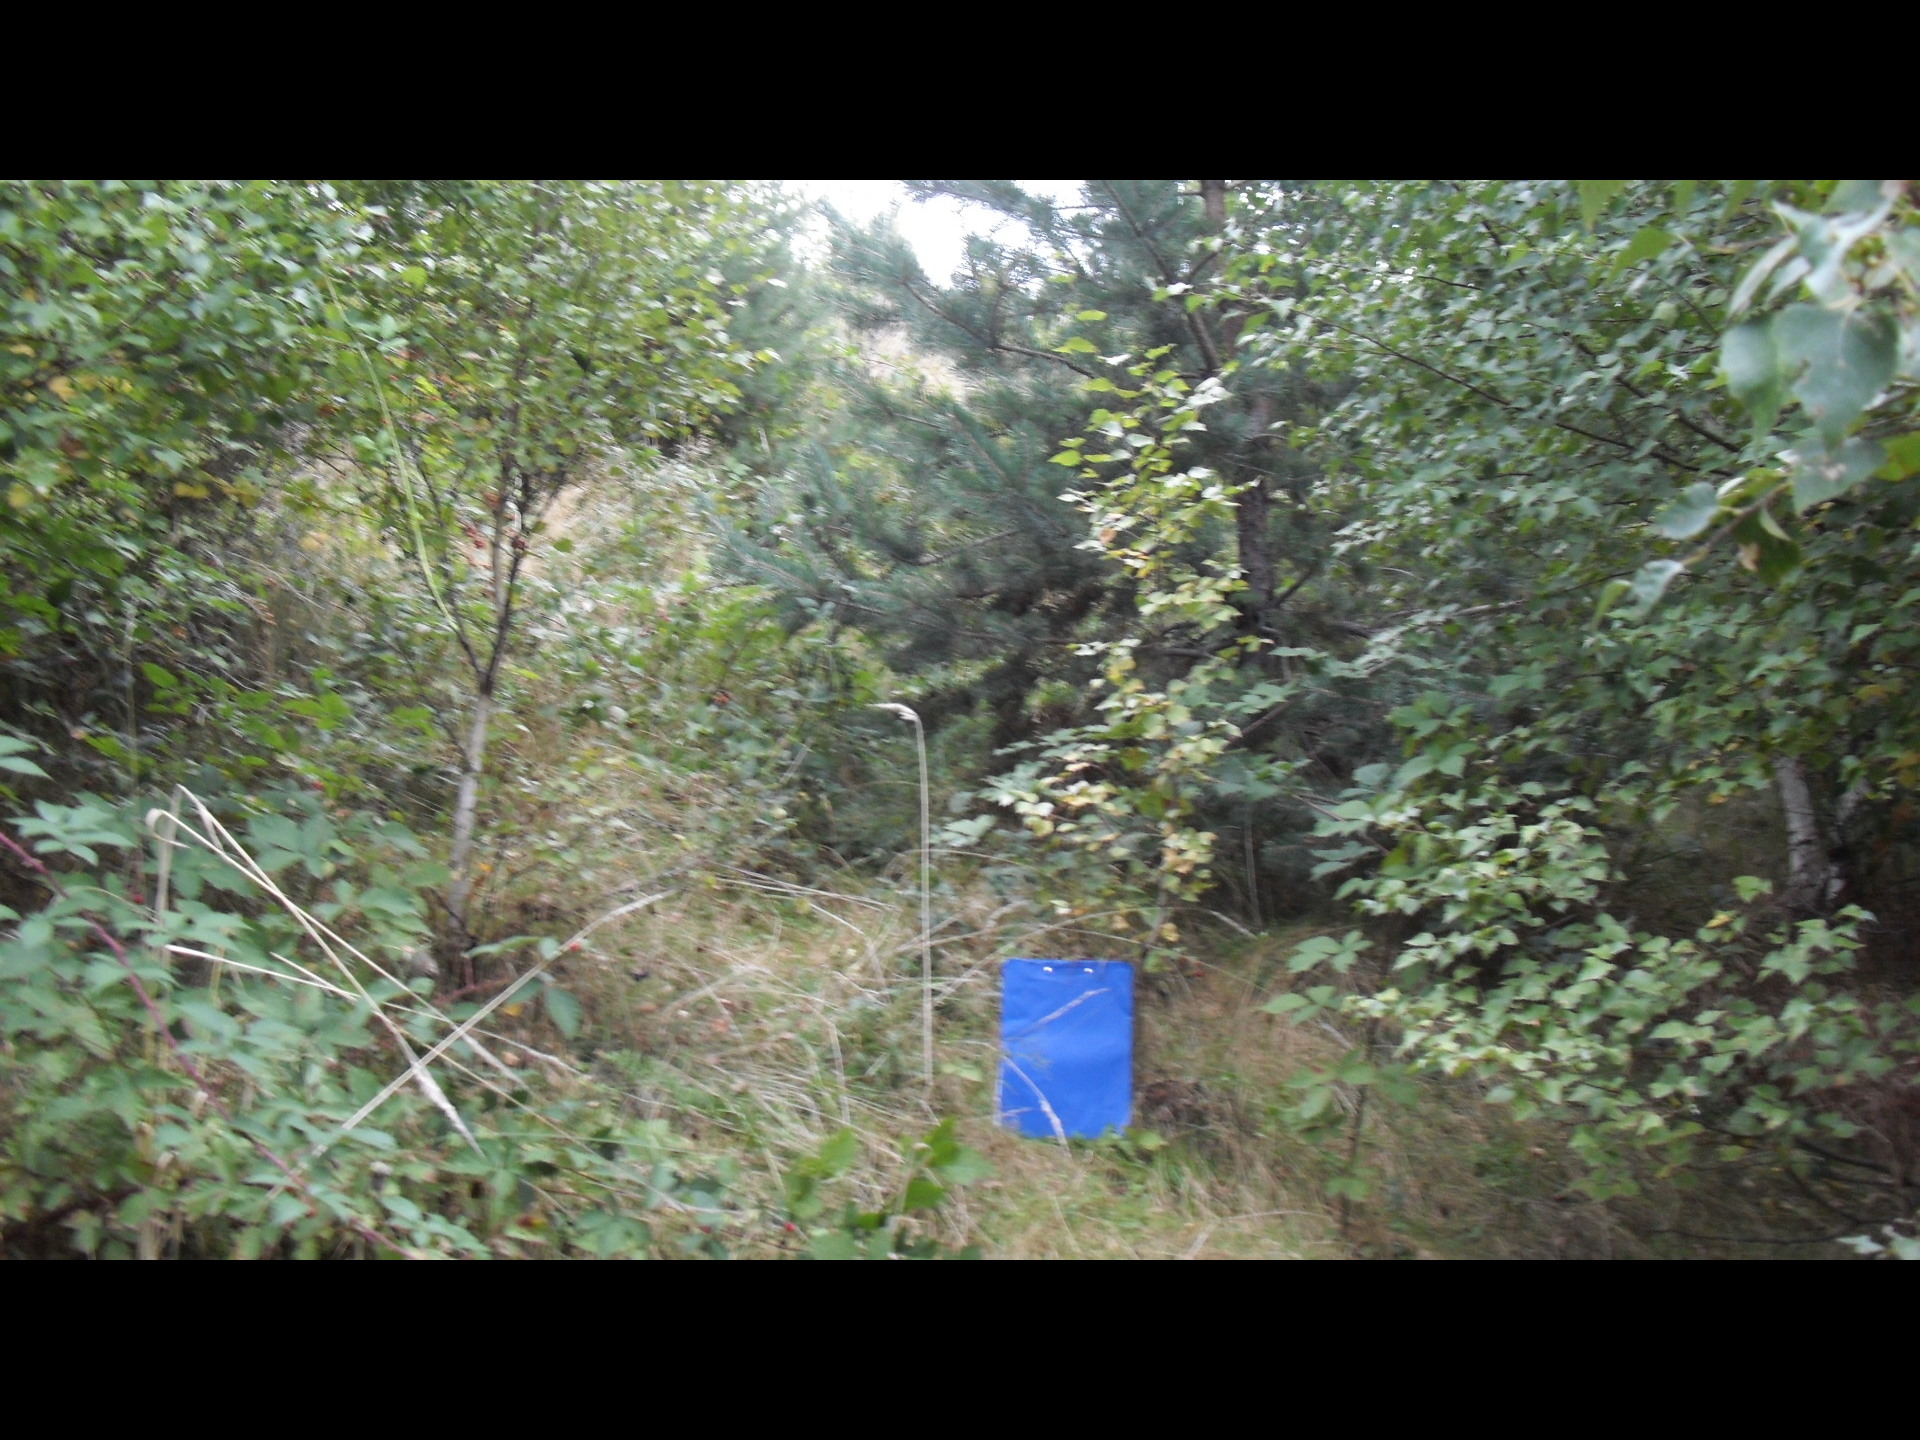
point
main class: Woodland
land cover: Broadleaved woodland
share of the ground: > 75 %
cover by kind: broadleaved forest trees 85 %, coniferous forest trees 10 %, shrubs 5 %
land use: Semi-natural and natural areas not in use
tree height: < 5 m
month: October
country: BG
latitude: 43.3887
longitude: 22.8104
